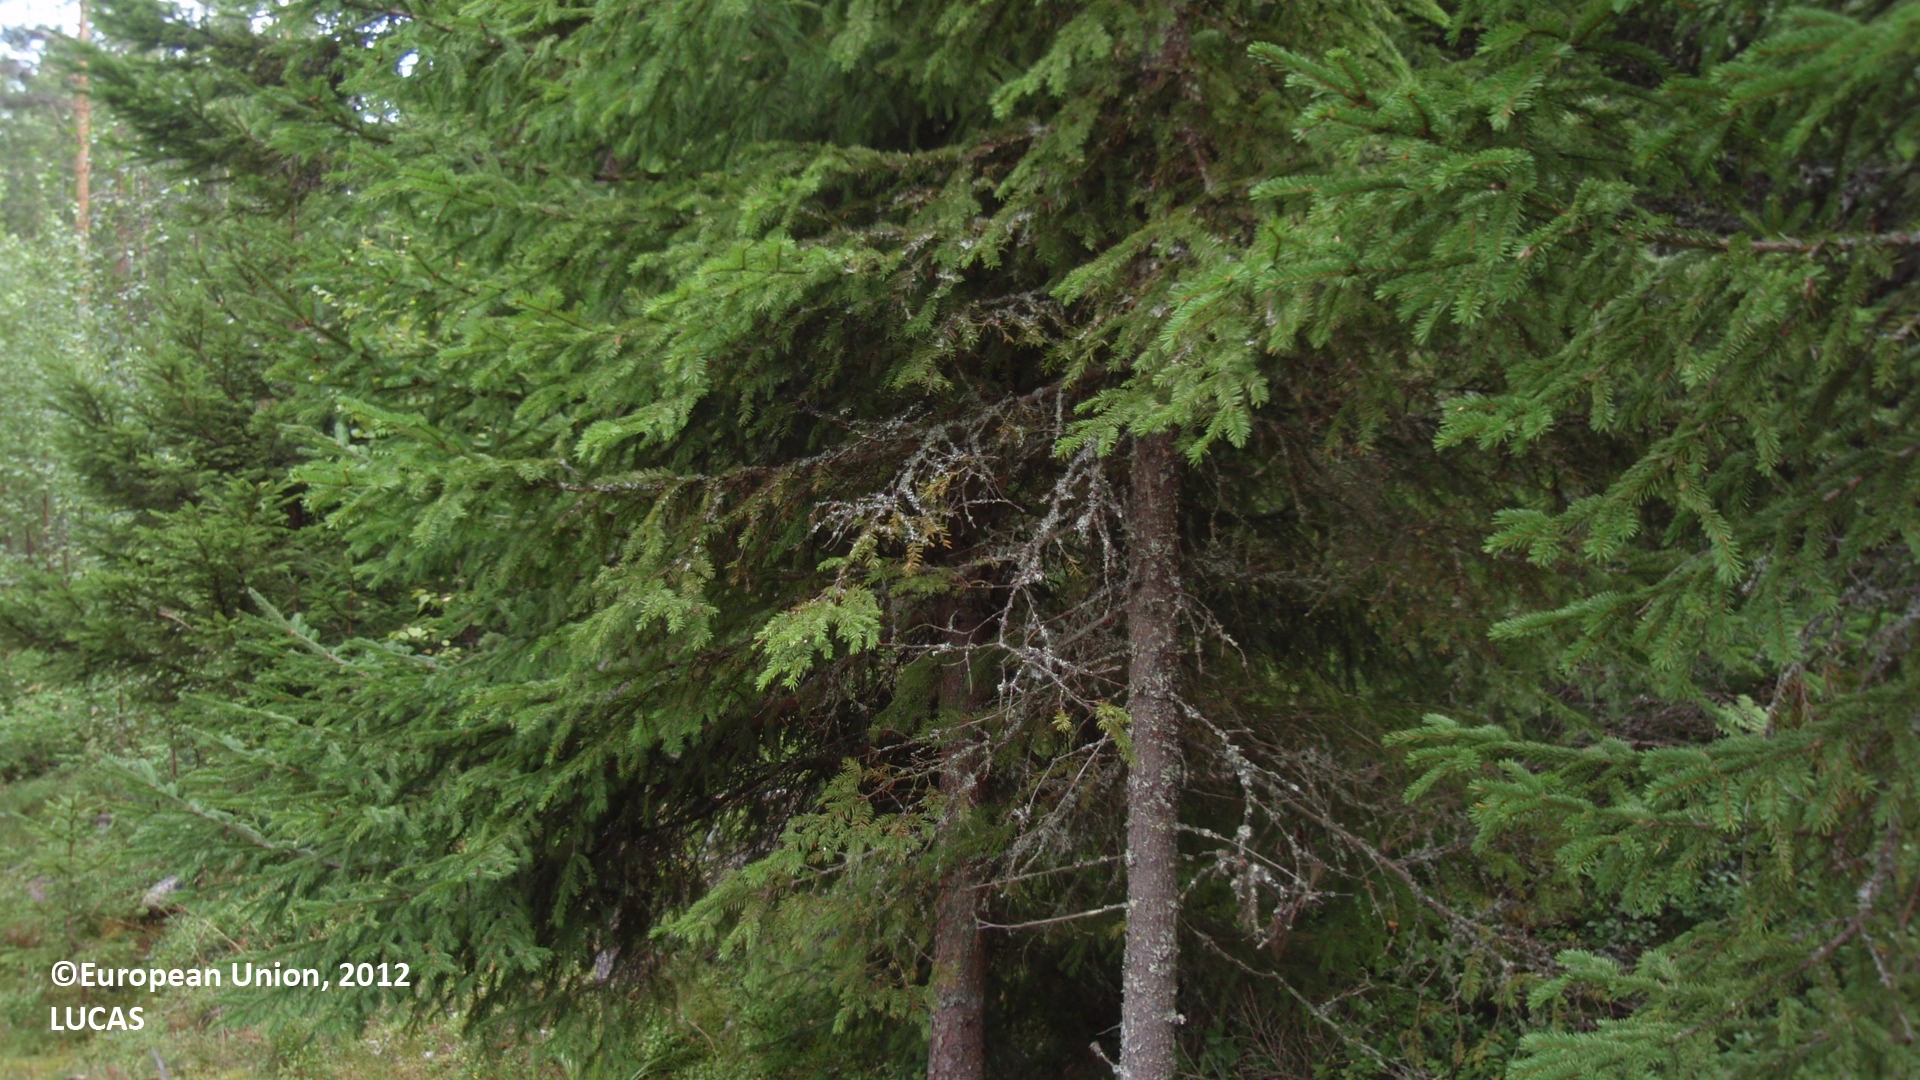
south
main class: Woodland
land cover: Spruce dominated mixed woodland
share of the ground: 50 - 75 %
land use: Forestry
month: August
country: FI
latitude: 60.9978
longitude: 27.6601
